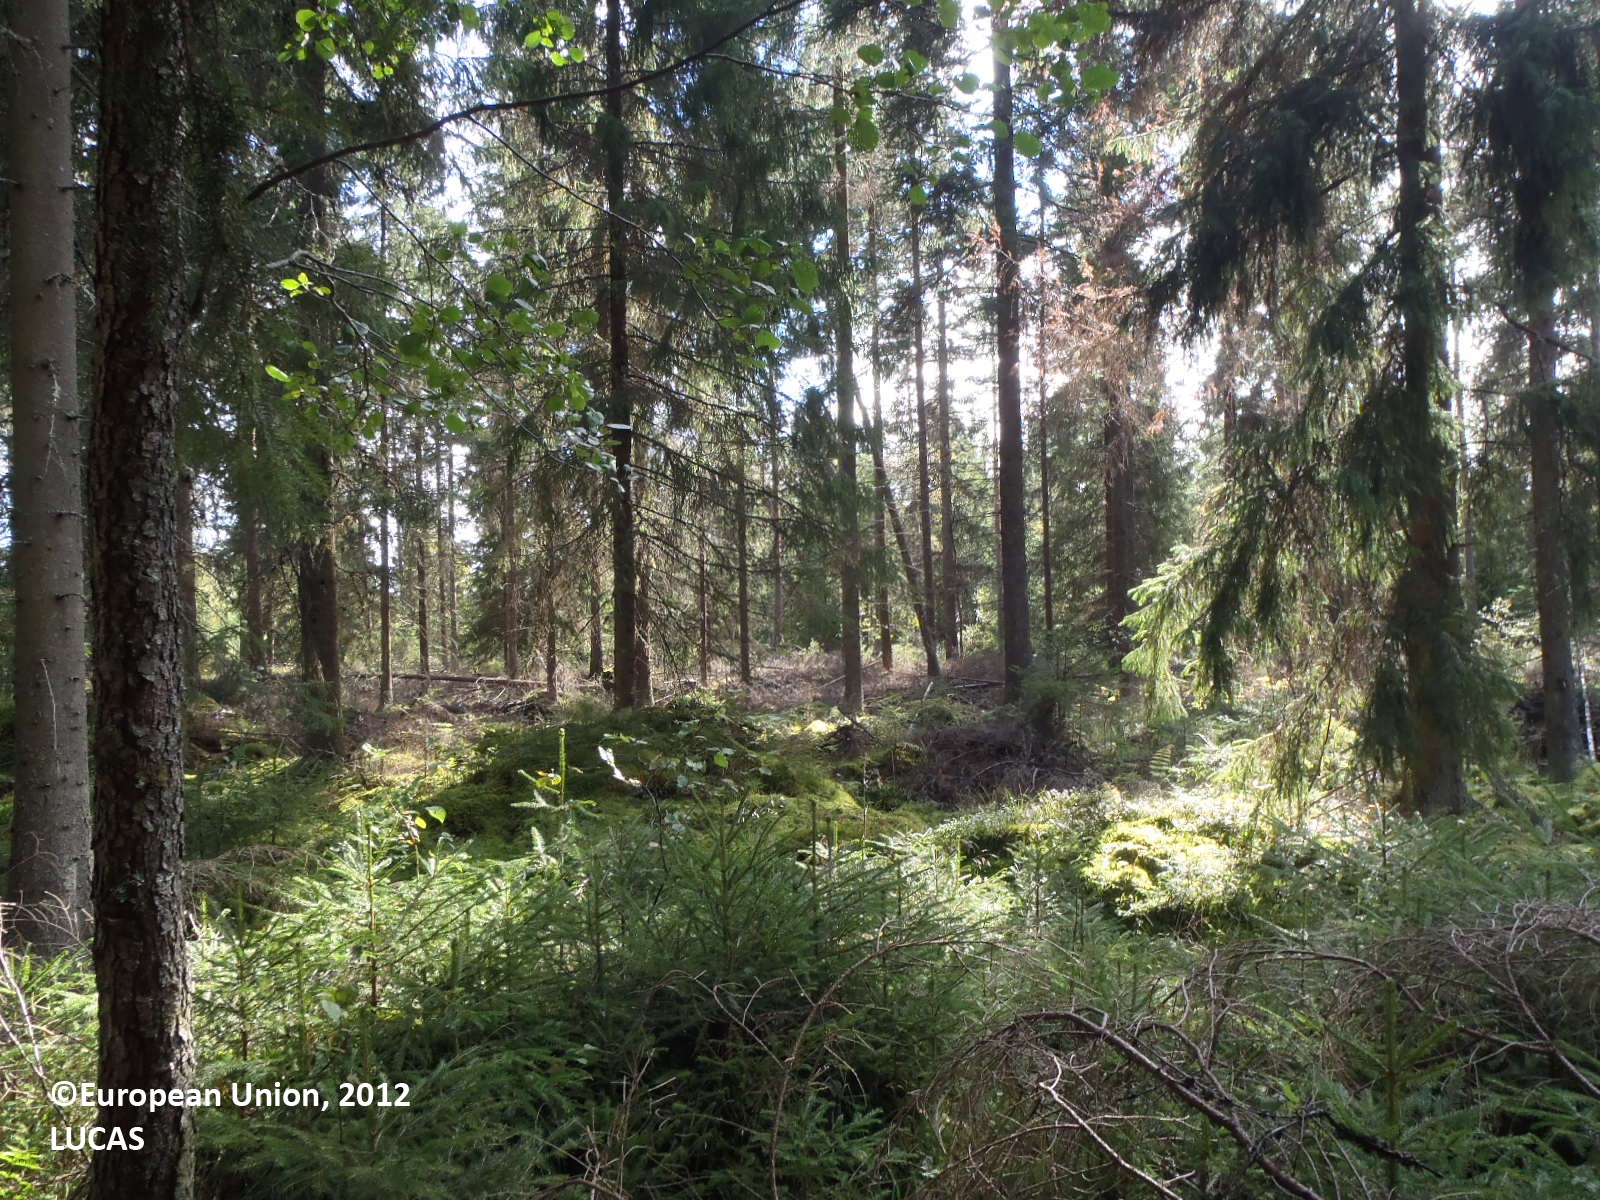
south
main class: Woodland
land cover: Spruce dominated coniferous woodland
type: boreal forest
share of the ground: > 75 %
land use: Forestry
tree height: > 5 m
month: September
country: FI
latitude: 61.1276
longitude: 22.4107
